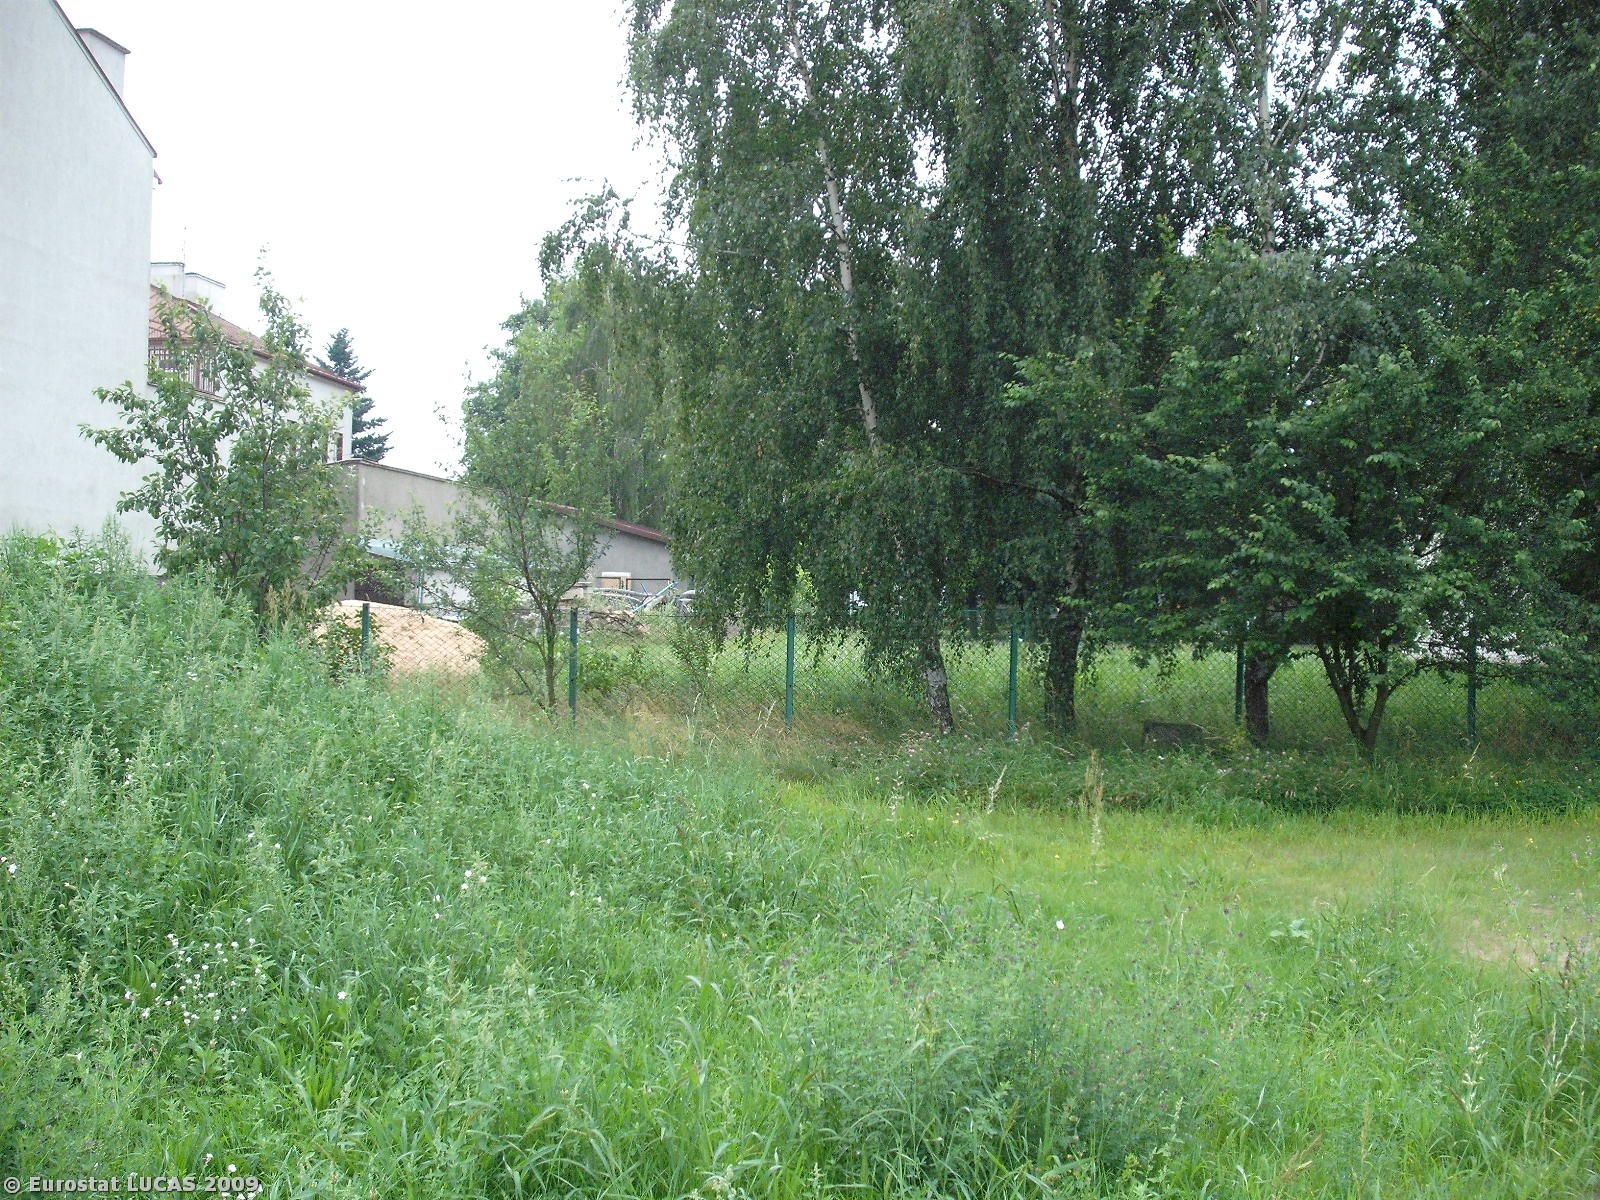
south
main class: Grassland
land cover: Grassland without tree/shrub cover
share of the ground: 25 - 50 %
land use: Community services
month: July
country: PL
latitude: 50.9577
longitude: 21.3674
